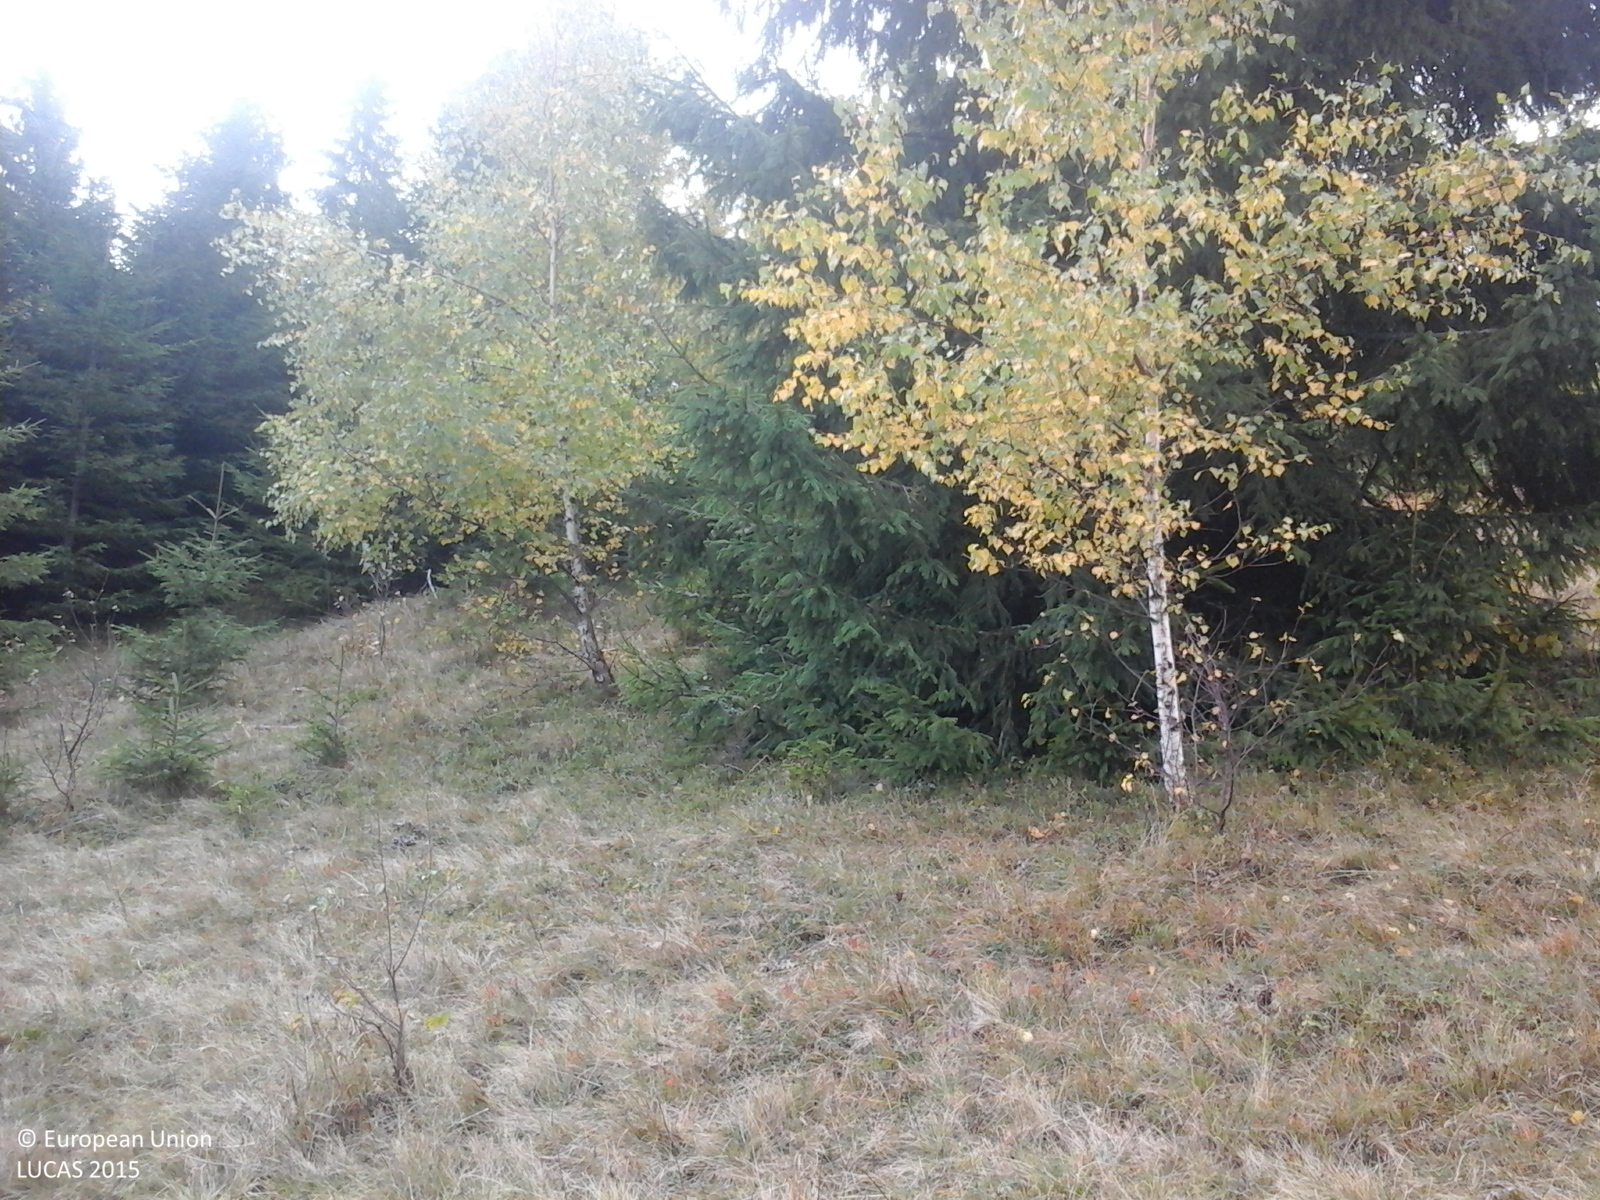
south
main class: Grassland
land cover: Grassland with sparse tree/shrub cover
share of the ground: > 75 %
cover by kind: herbaceous plants 85 %, shrubs 10 %, coniferous forest trees 5 %
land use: Forestry
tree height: < 5 m
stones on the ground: < 10 %
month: October
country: RO
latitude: 46.2896
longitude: 26.0208
